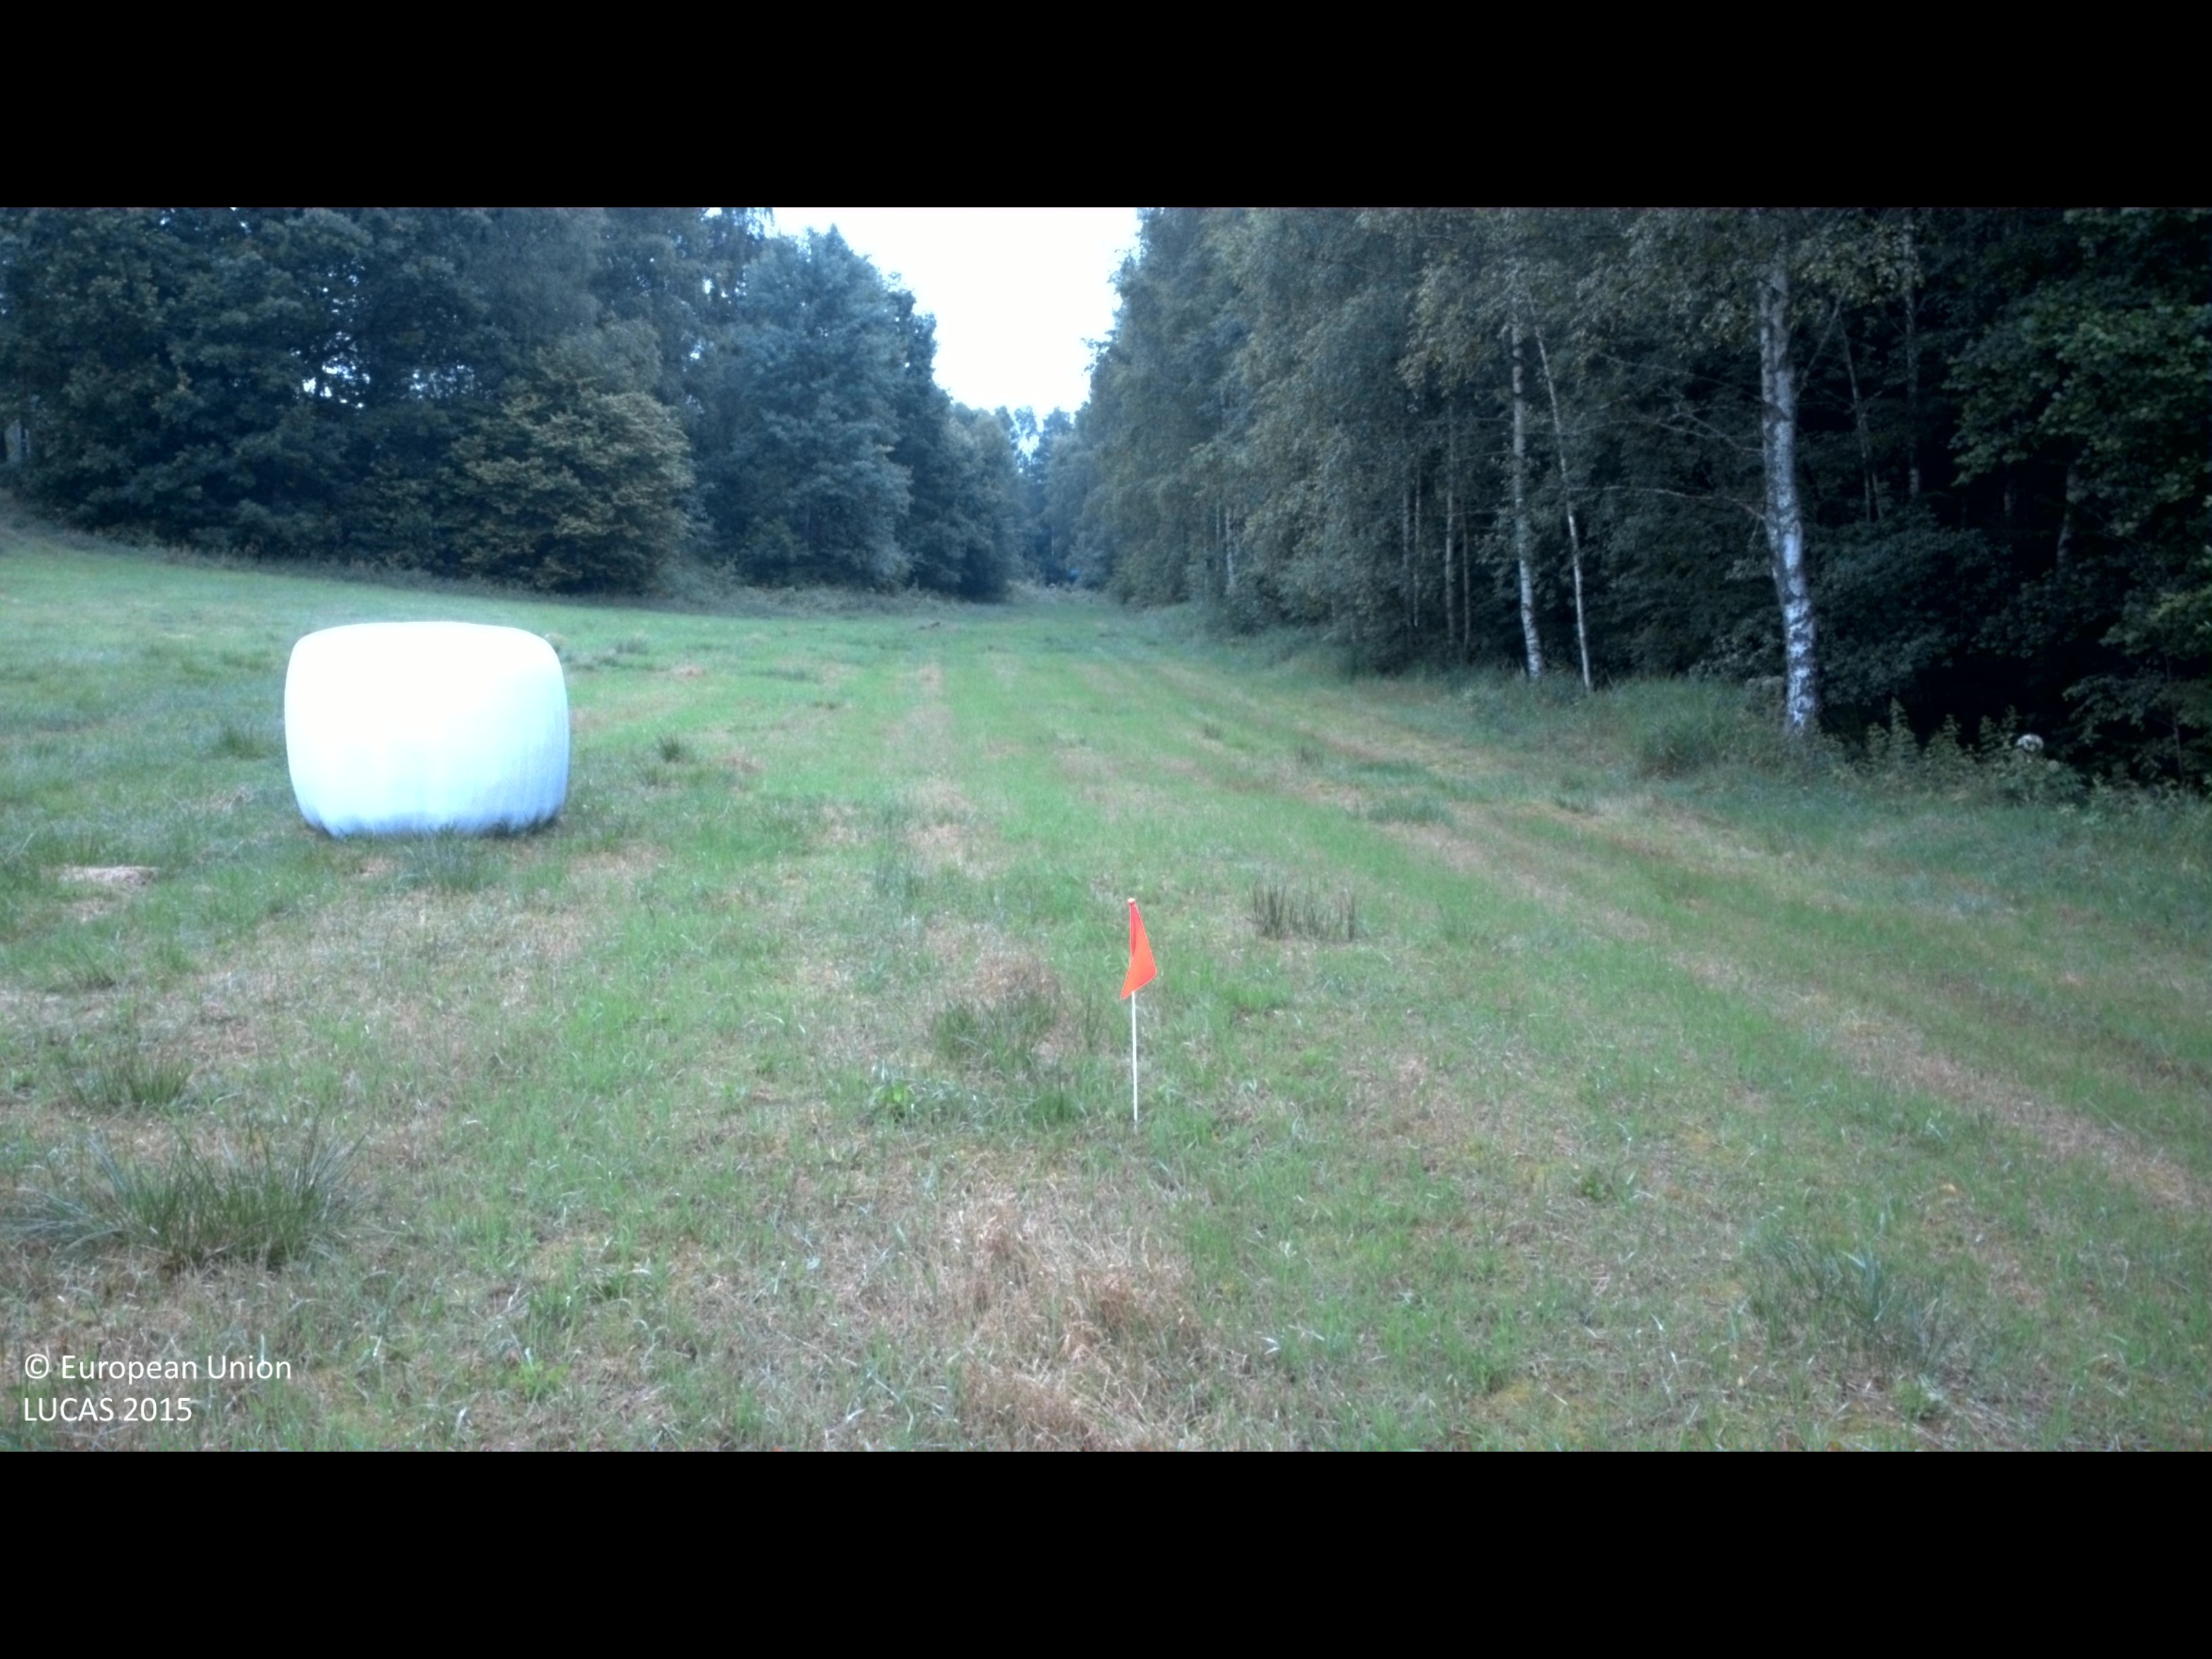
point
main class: Grassland
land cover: Grassland without tree/shrub cover
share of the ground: 50 - 75 %
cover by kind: herbaceous plants 60 %, lichens and mosses 40 %
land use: Agriculture (excluding fallow land and kitchen gardens)
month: July
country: SE
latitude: 56.4843
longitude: 14.0406
